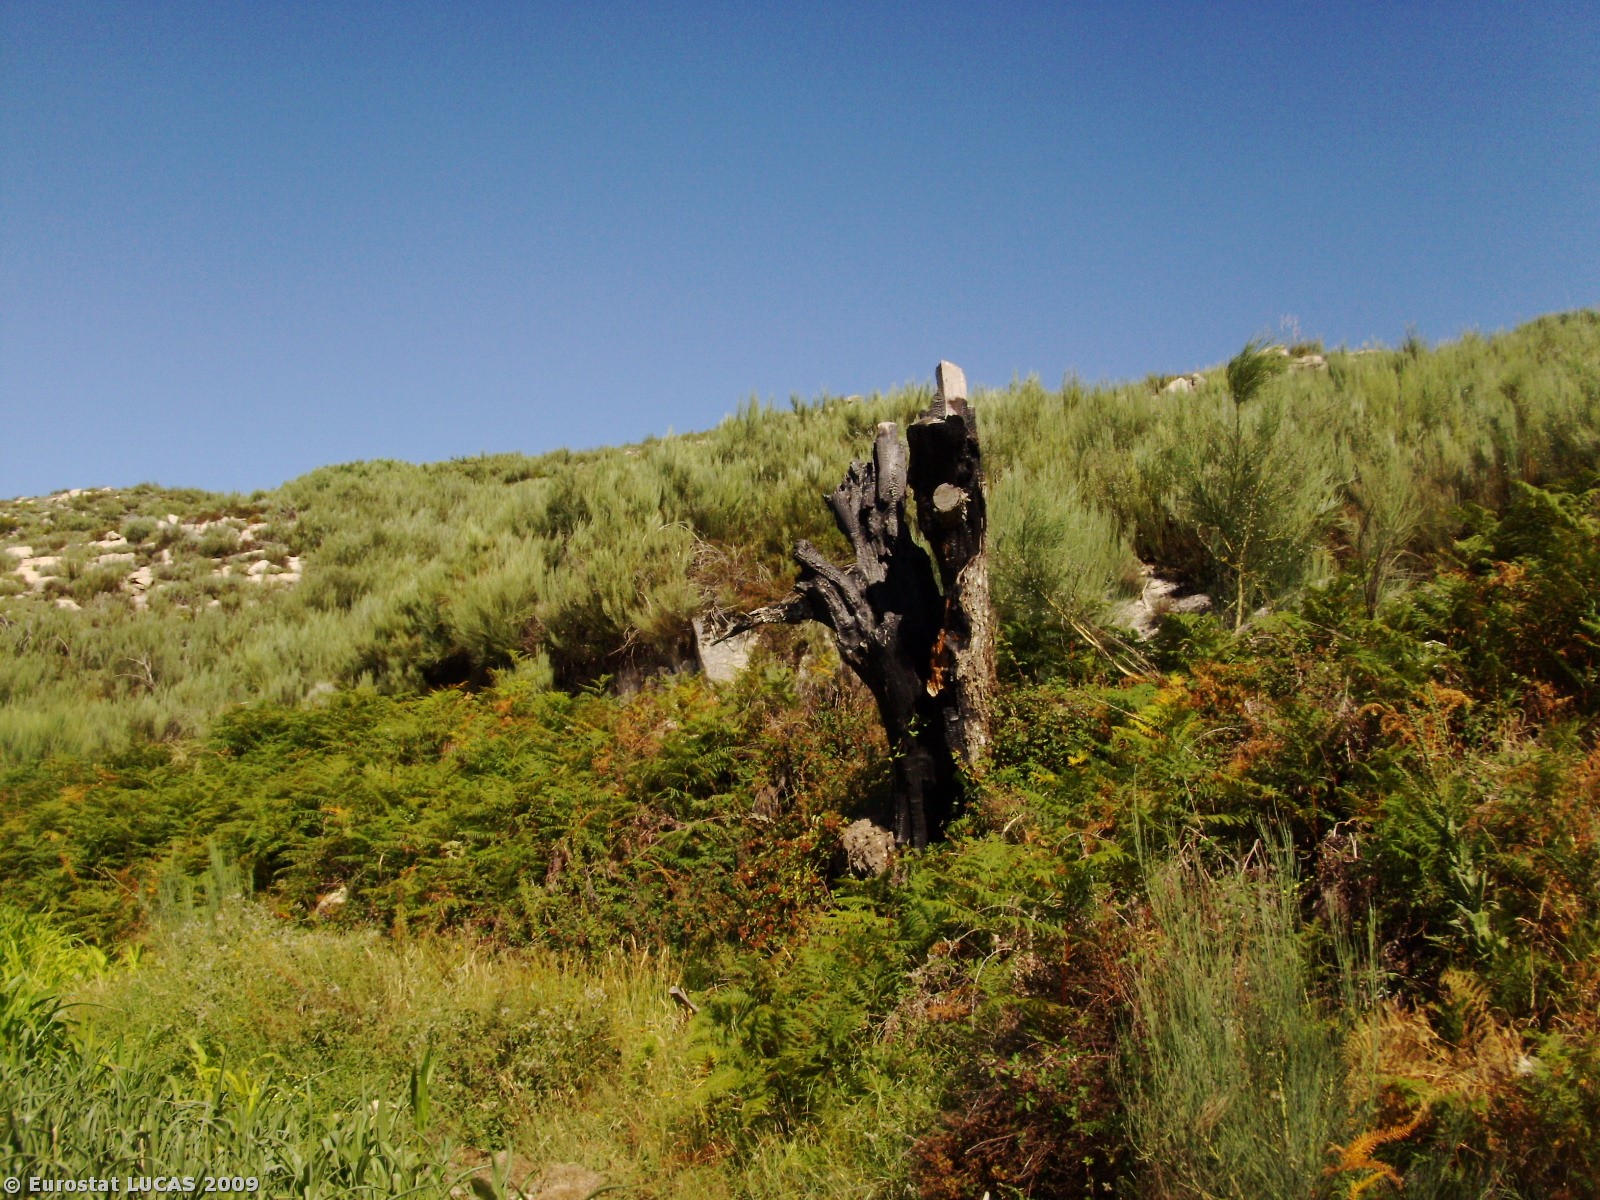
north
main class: Cropland
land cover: Maize
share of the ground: > 75 %
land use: Agriculture (excluding fallow land and kitchen gardens)
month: July
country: PT
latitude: 40.4850
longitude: -7.3183
